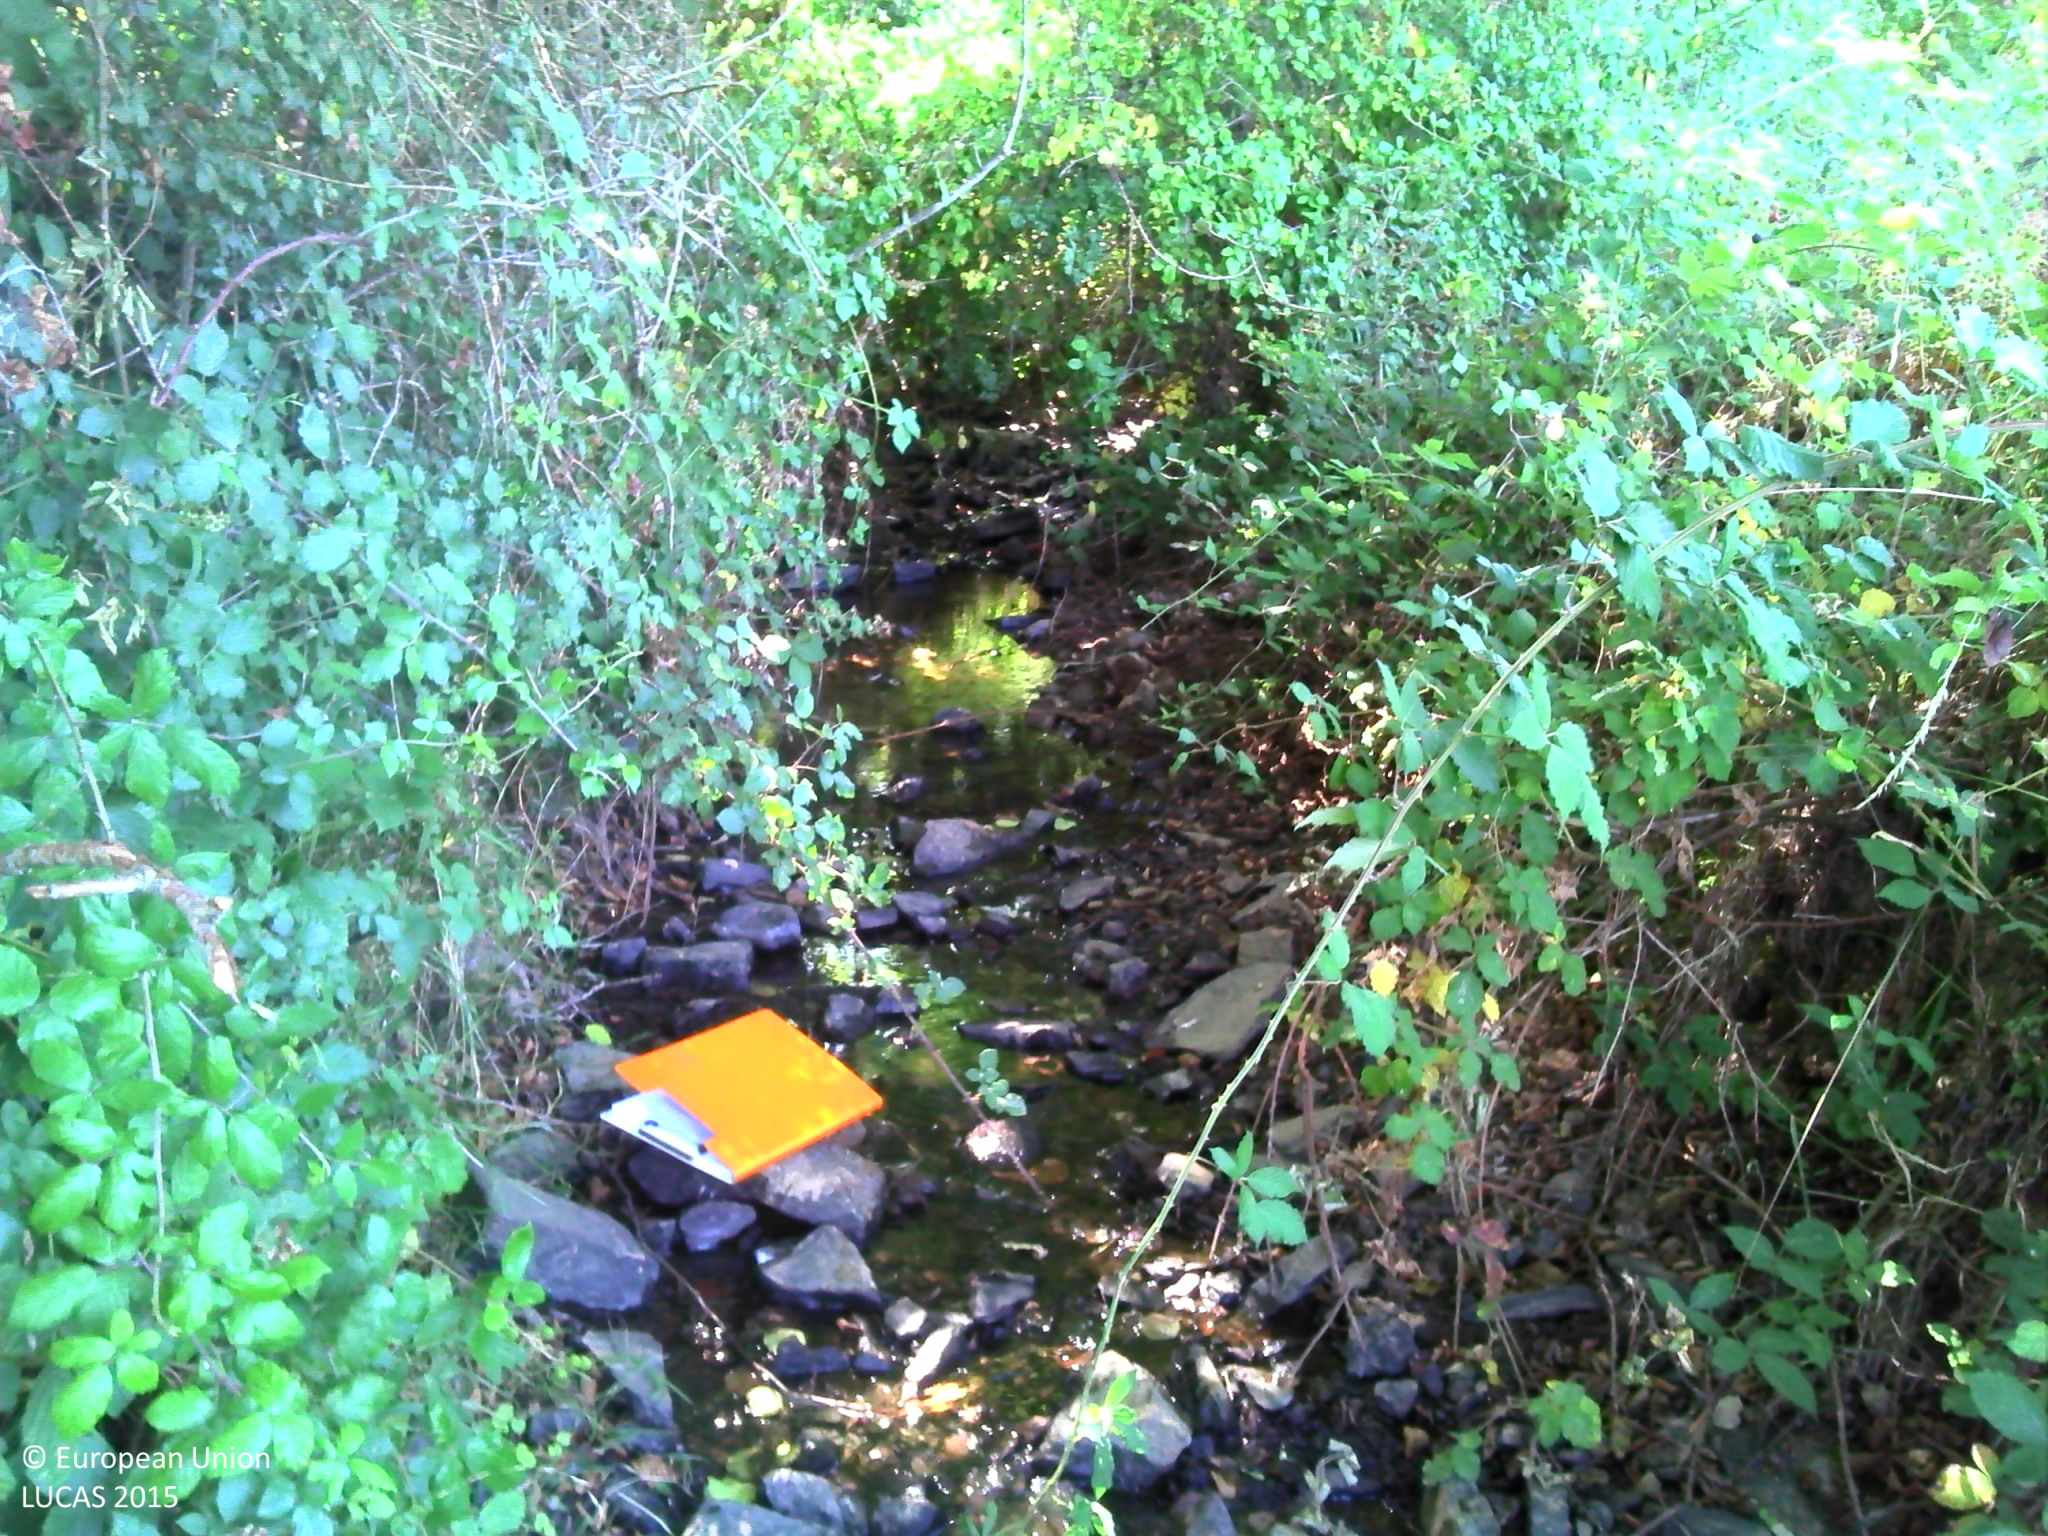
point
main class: Woodland
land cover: Broadleaved woodland
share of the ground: > 75 %
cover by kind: broadleaved forest trees 90 %, shrubs 10 %
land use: Agriculture (excluding fallow land and kitchen gardens)
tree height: > 5 m
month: July
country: FR
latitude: 46.5352
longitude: 2.1832
